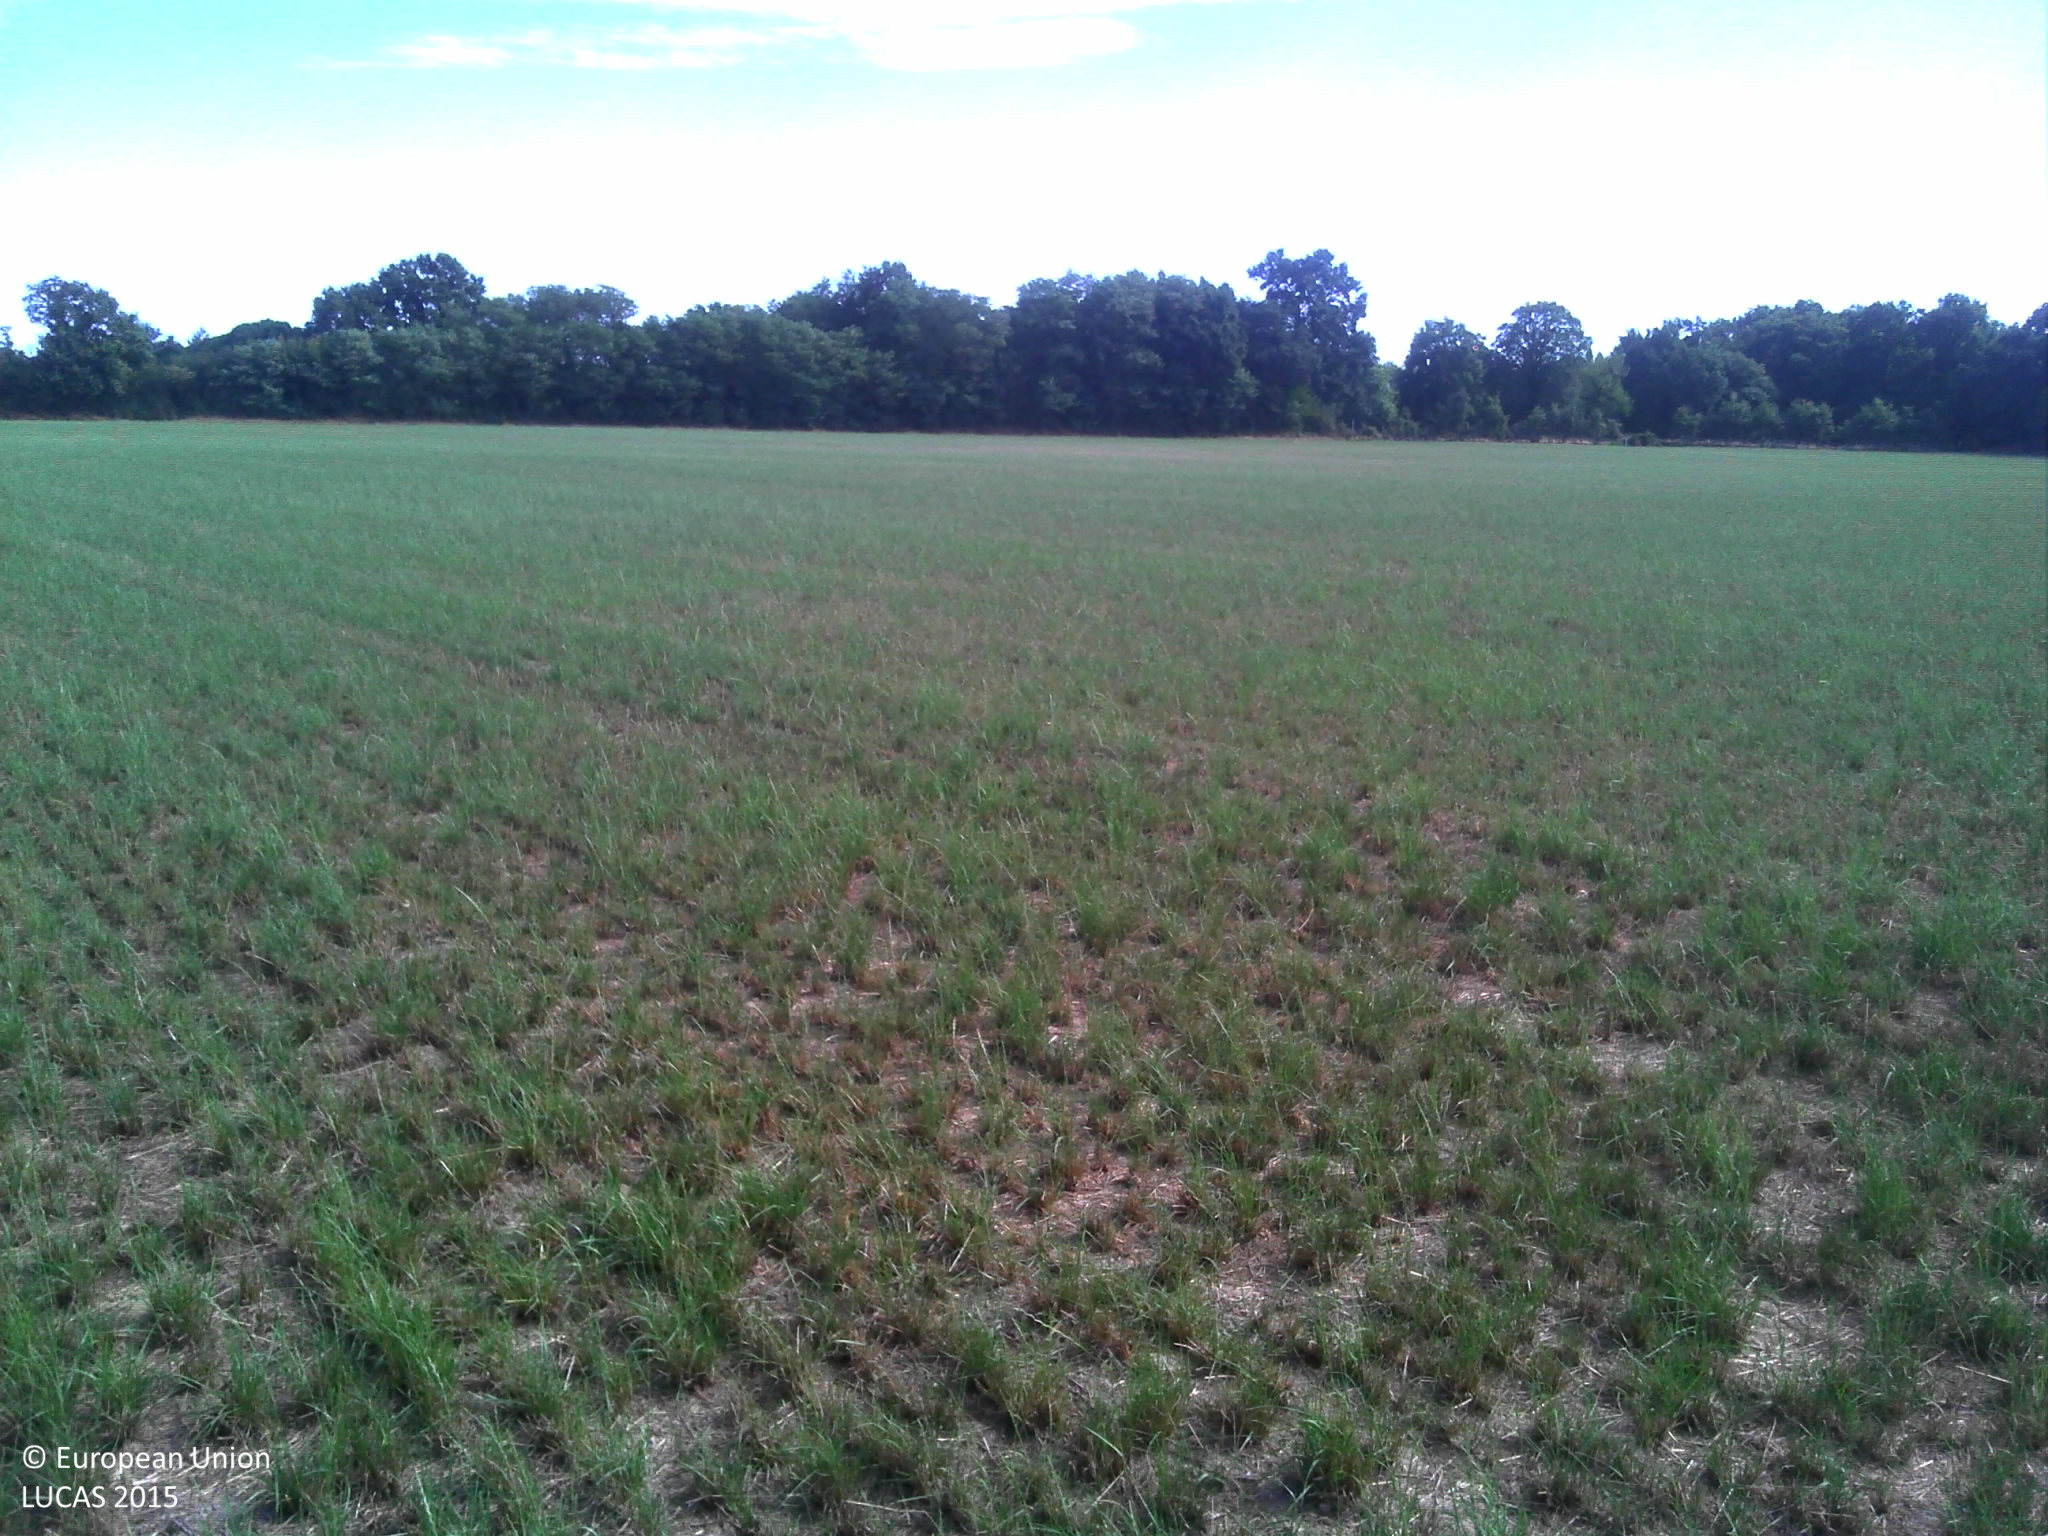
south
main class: Cropland
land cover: Temporary grasslands
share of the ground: > 75 %
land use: Agriculture (excluding fallow land and kitchen gardens)
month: August
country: FR
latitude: 46.7288
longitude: -1.3294
